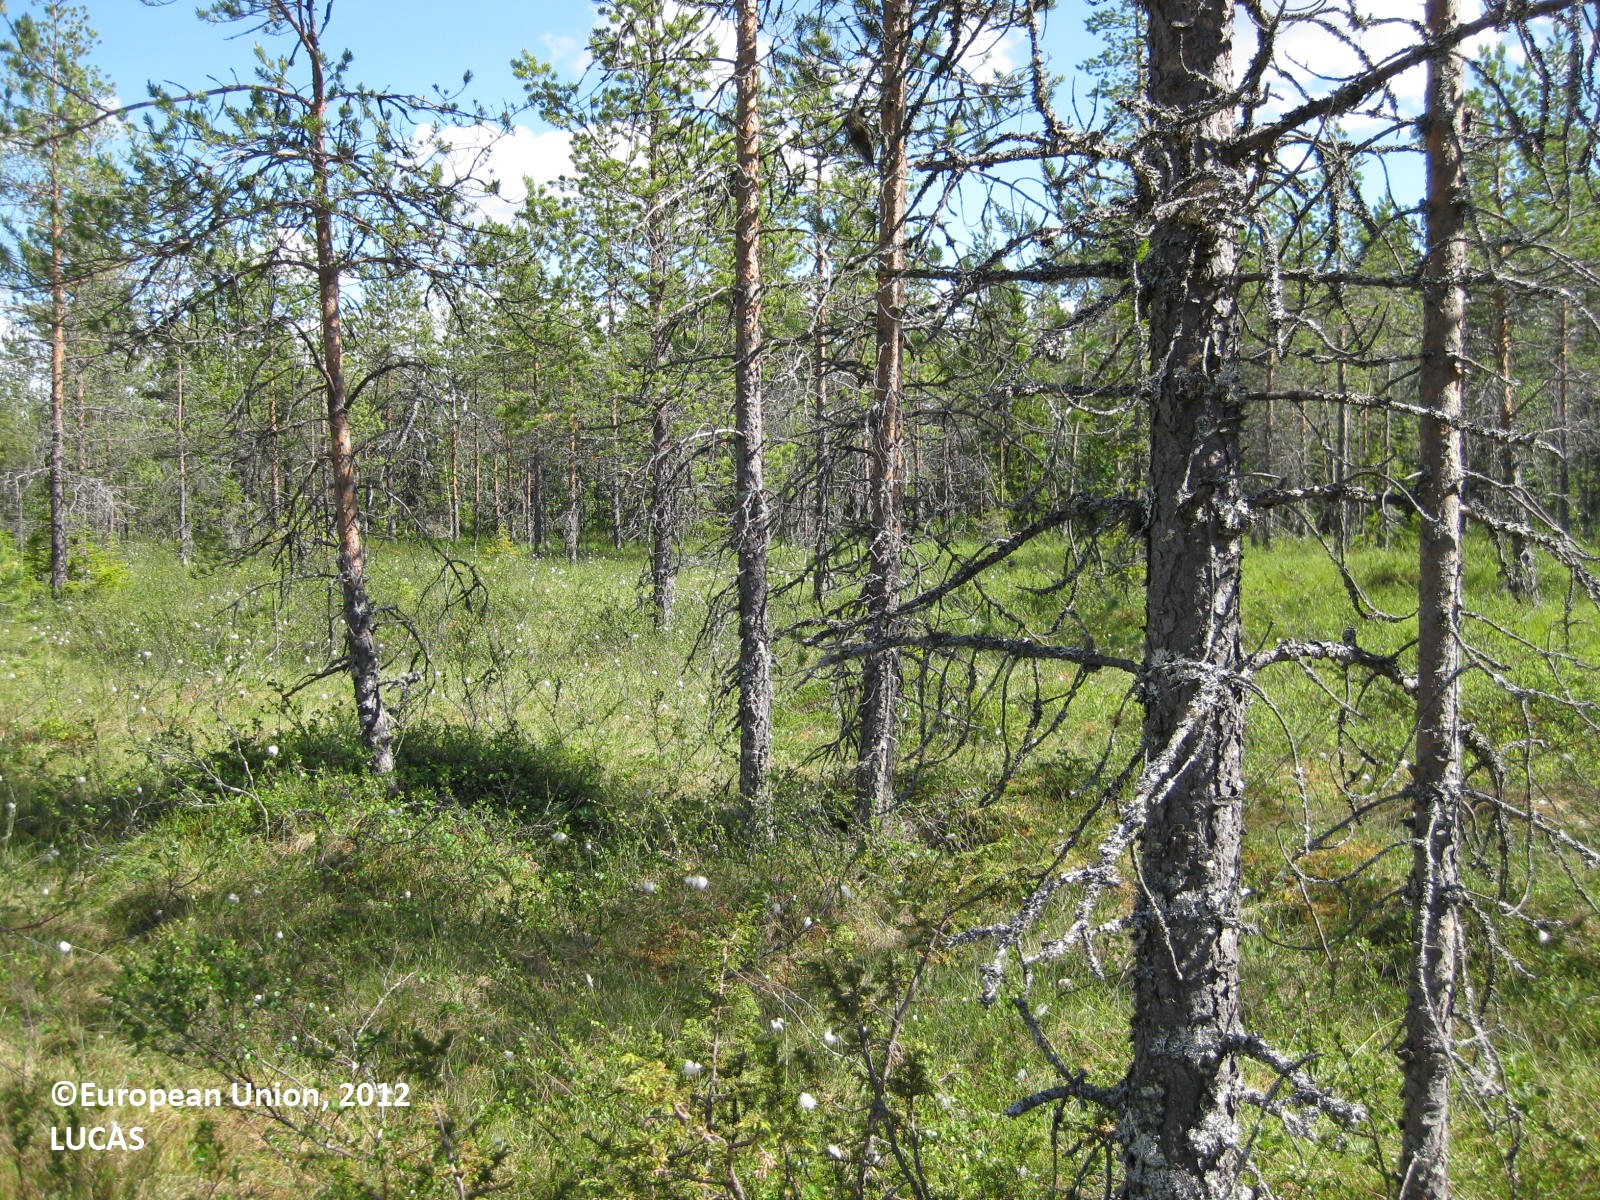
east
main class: Woodland
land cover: Pine dominated coniferous woodland
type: boreal forest
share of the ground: 50 - 75 %
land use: Forestry
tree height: > 5 m
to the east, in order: Pine dominated coniferous woodland; Pine dominated mixed woodland; Ditches and canals; Pine dominated mixed woodland; Ditches and canals; Pine dominated mixed woodland; Broadleaved woodland; Ditches and canals; Broadleaved woodland; Ditches and canals; Shrubland with sparse tree cover; Ditches and canals; Pine dominated coniferous woodland; Ditches and canals; Broadleaved woodland; Shrubland without tree cover; Electric lines; Shrubland without tree cover; Pine dominated mixed woodland
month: July
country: FI
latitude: 65.6085
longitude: 29.4886
